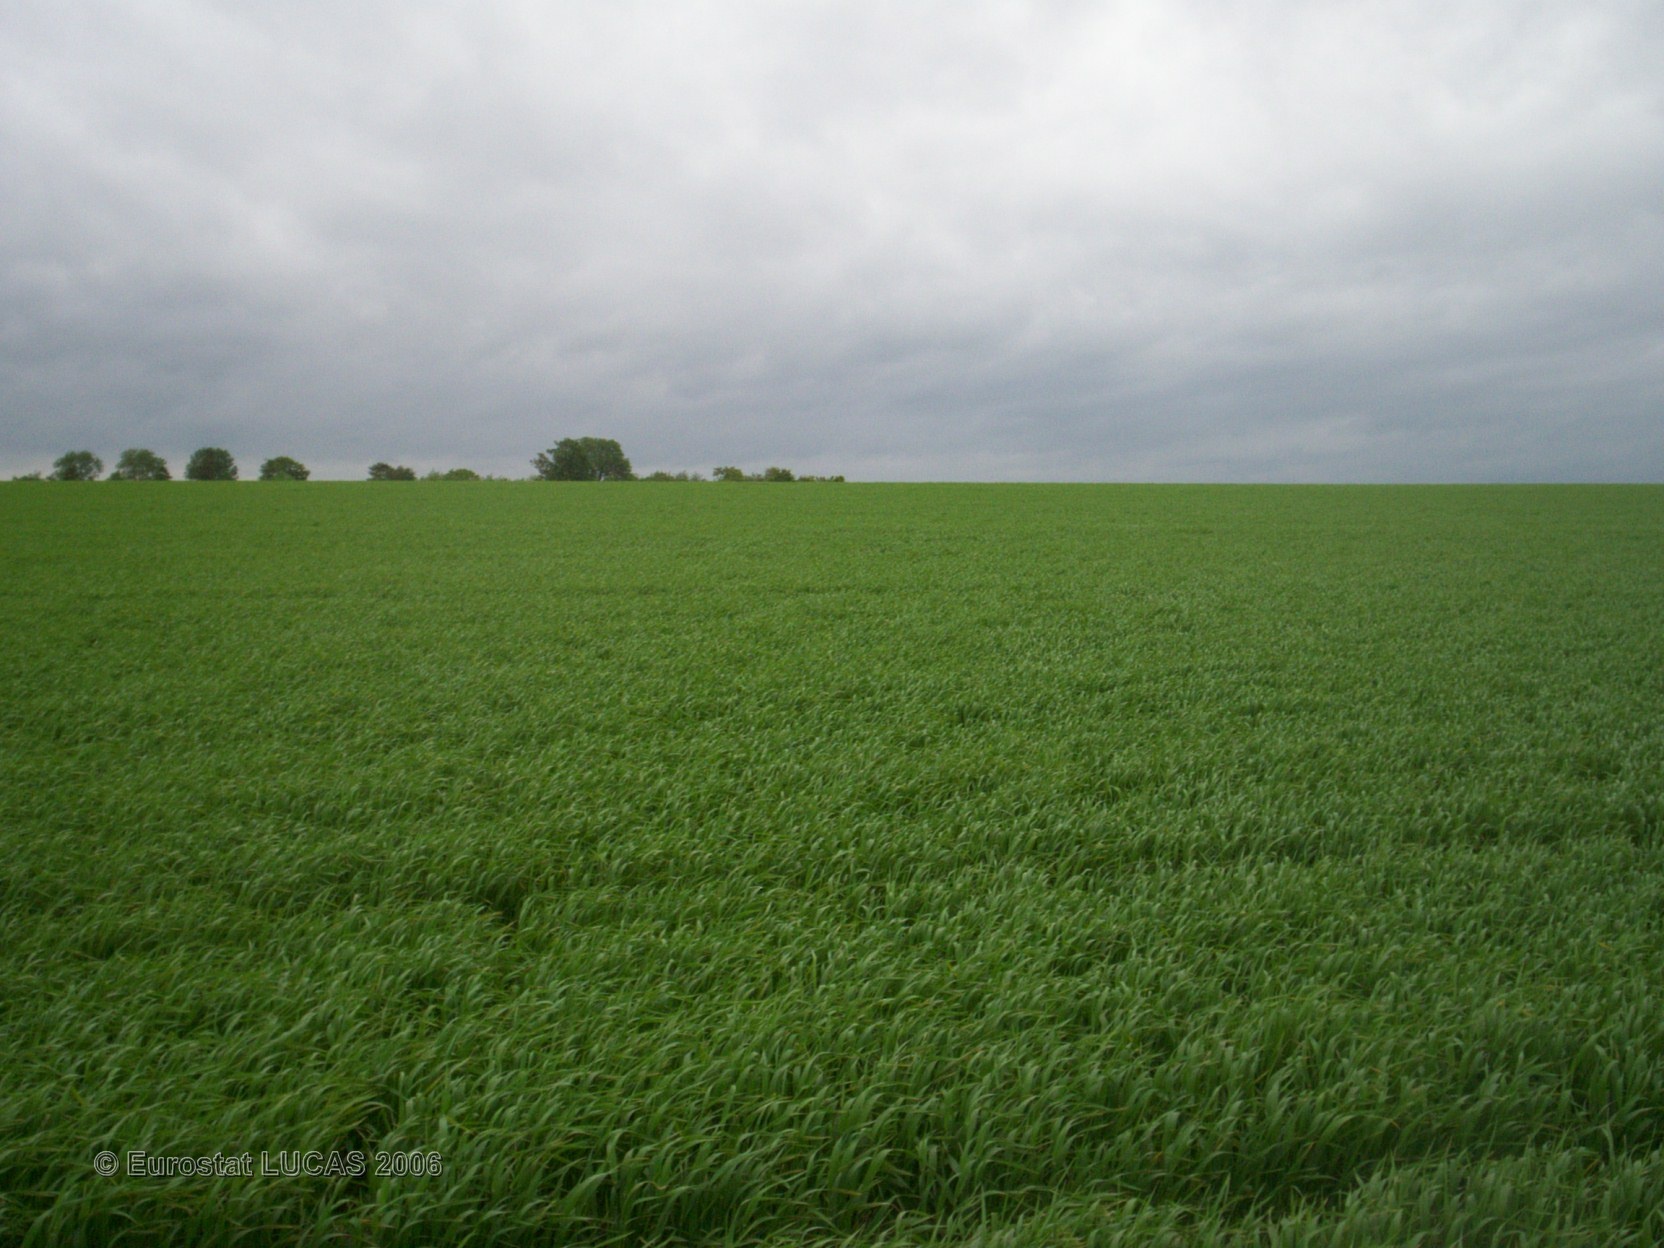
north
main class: Cropland
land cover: Barley
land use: Agriculture (excluding fallow land and kitchen gardens)
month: May
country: FR
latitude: 49.3598
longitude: 4.3646
